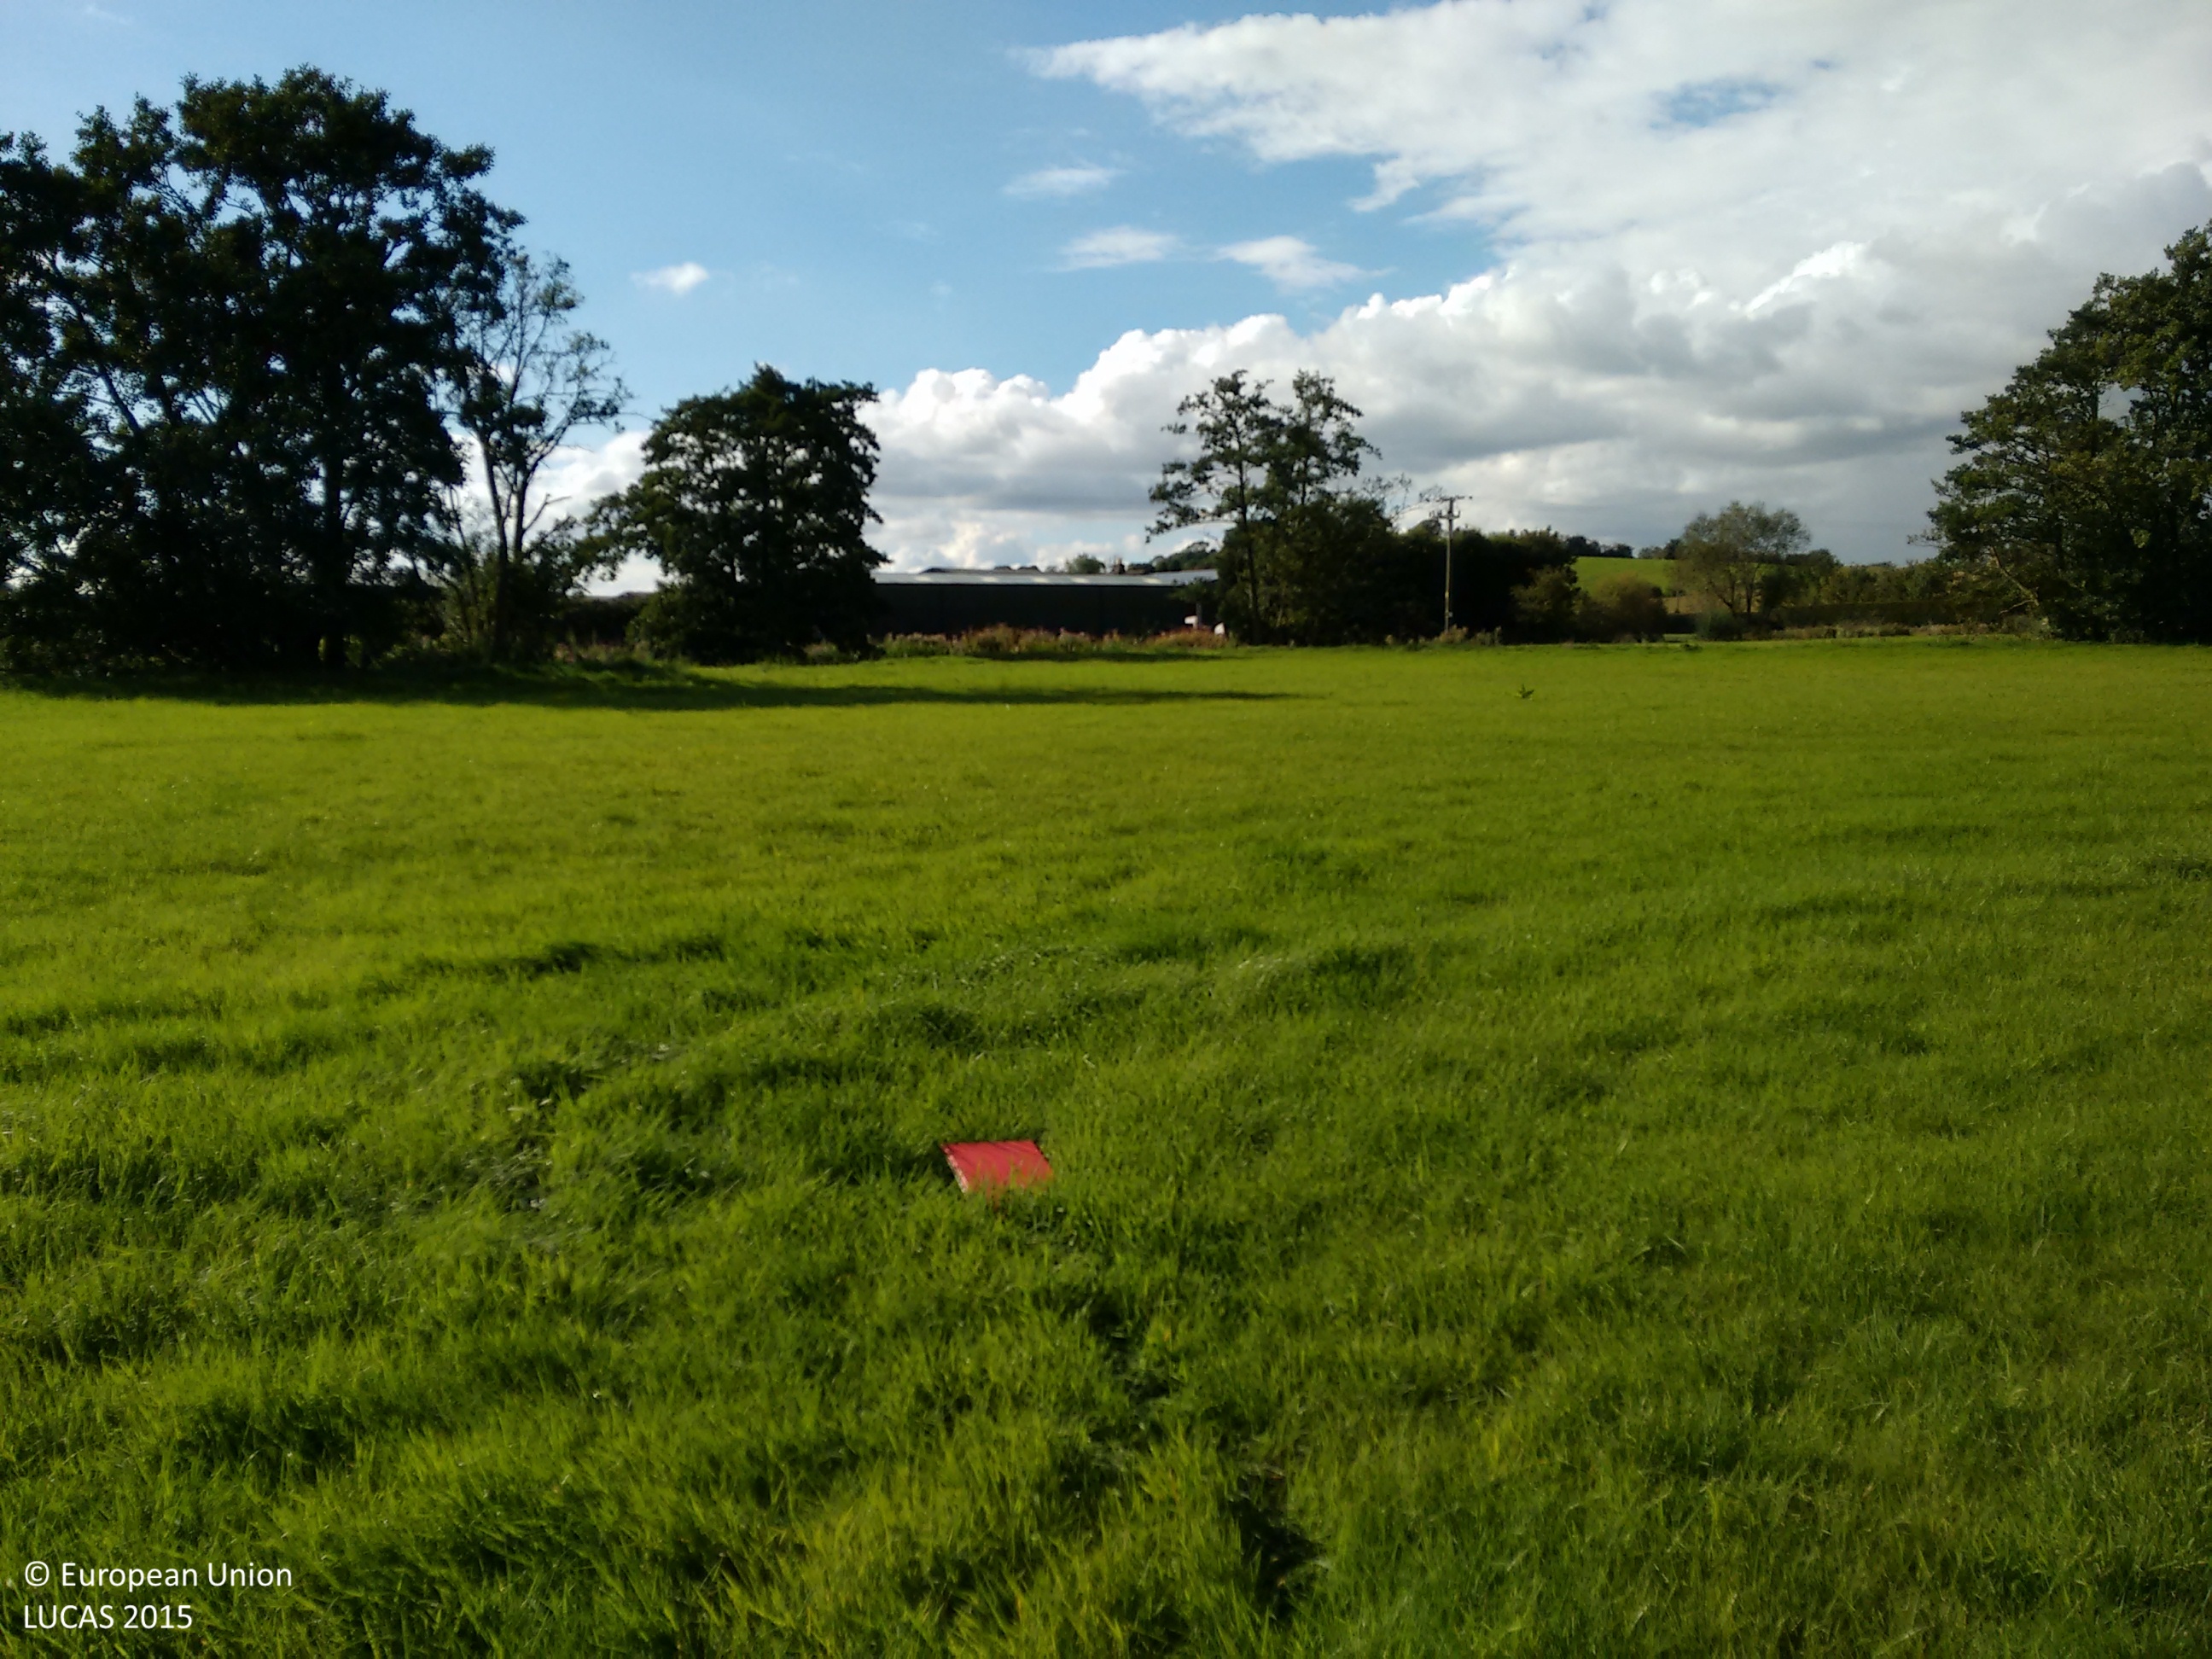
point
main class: Grassland
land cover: Grassland without tree/shrub cover
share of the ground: > 75 %
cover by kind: herbaceous plants 100 %
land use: Agriculture (excluding fallow land and kitchen gardens)
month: September
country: GB
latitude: 52.7643
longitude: -1.8375
